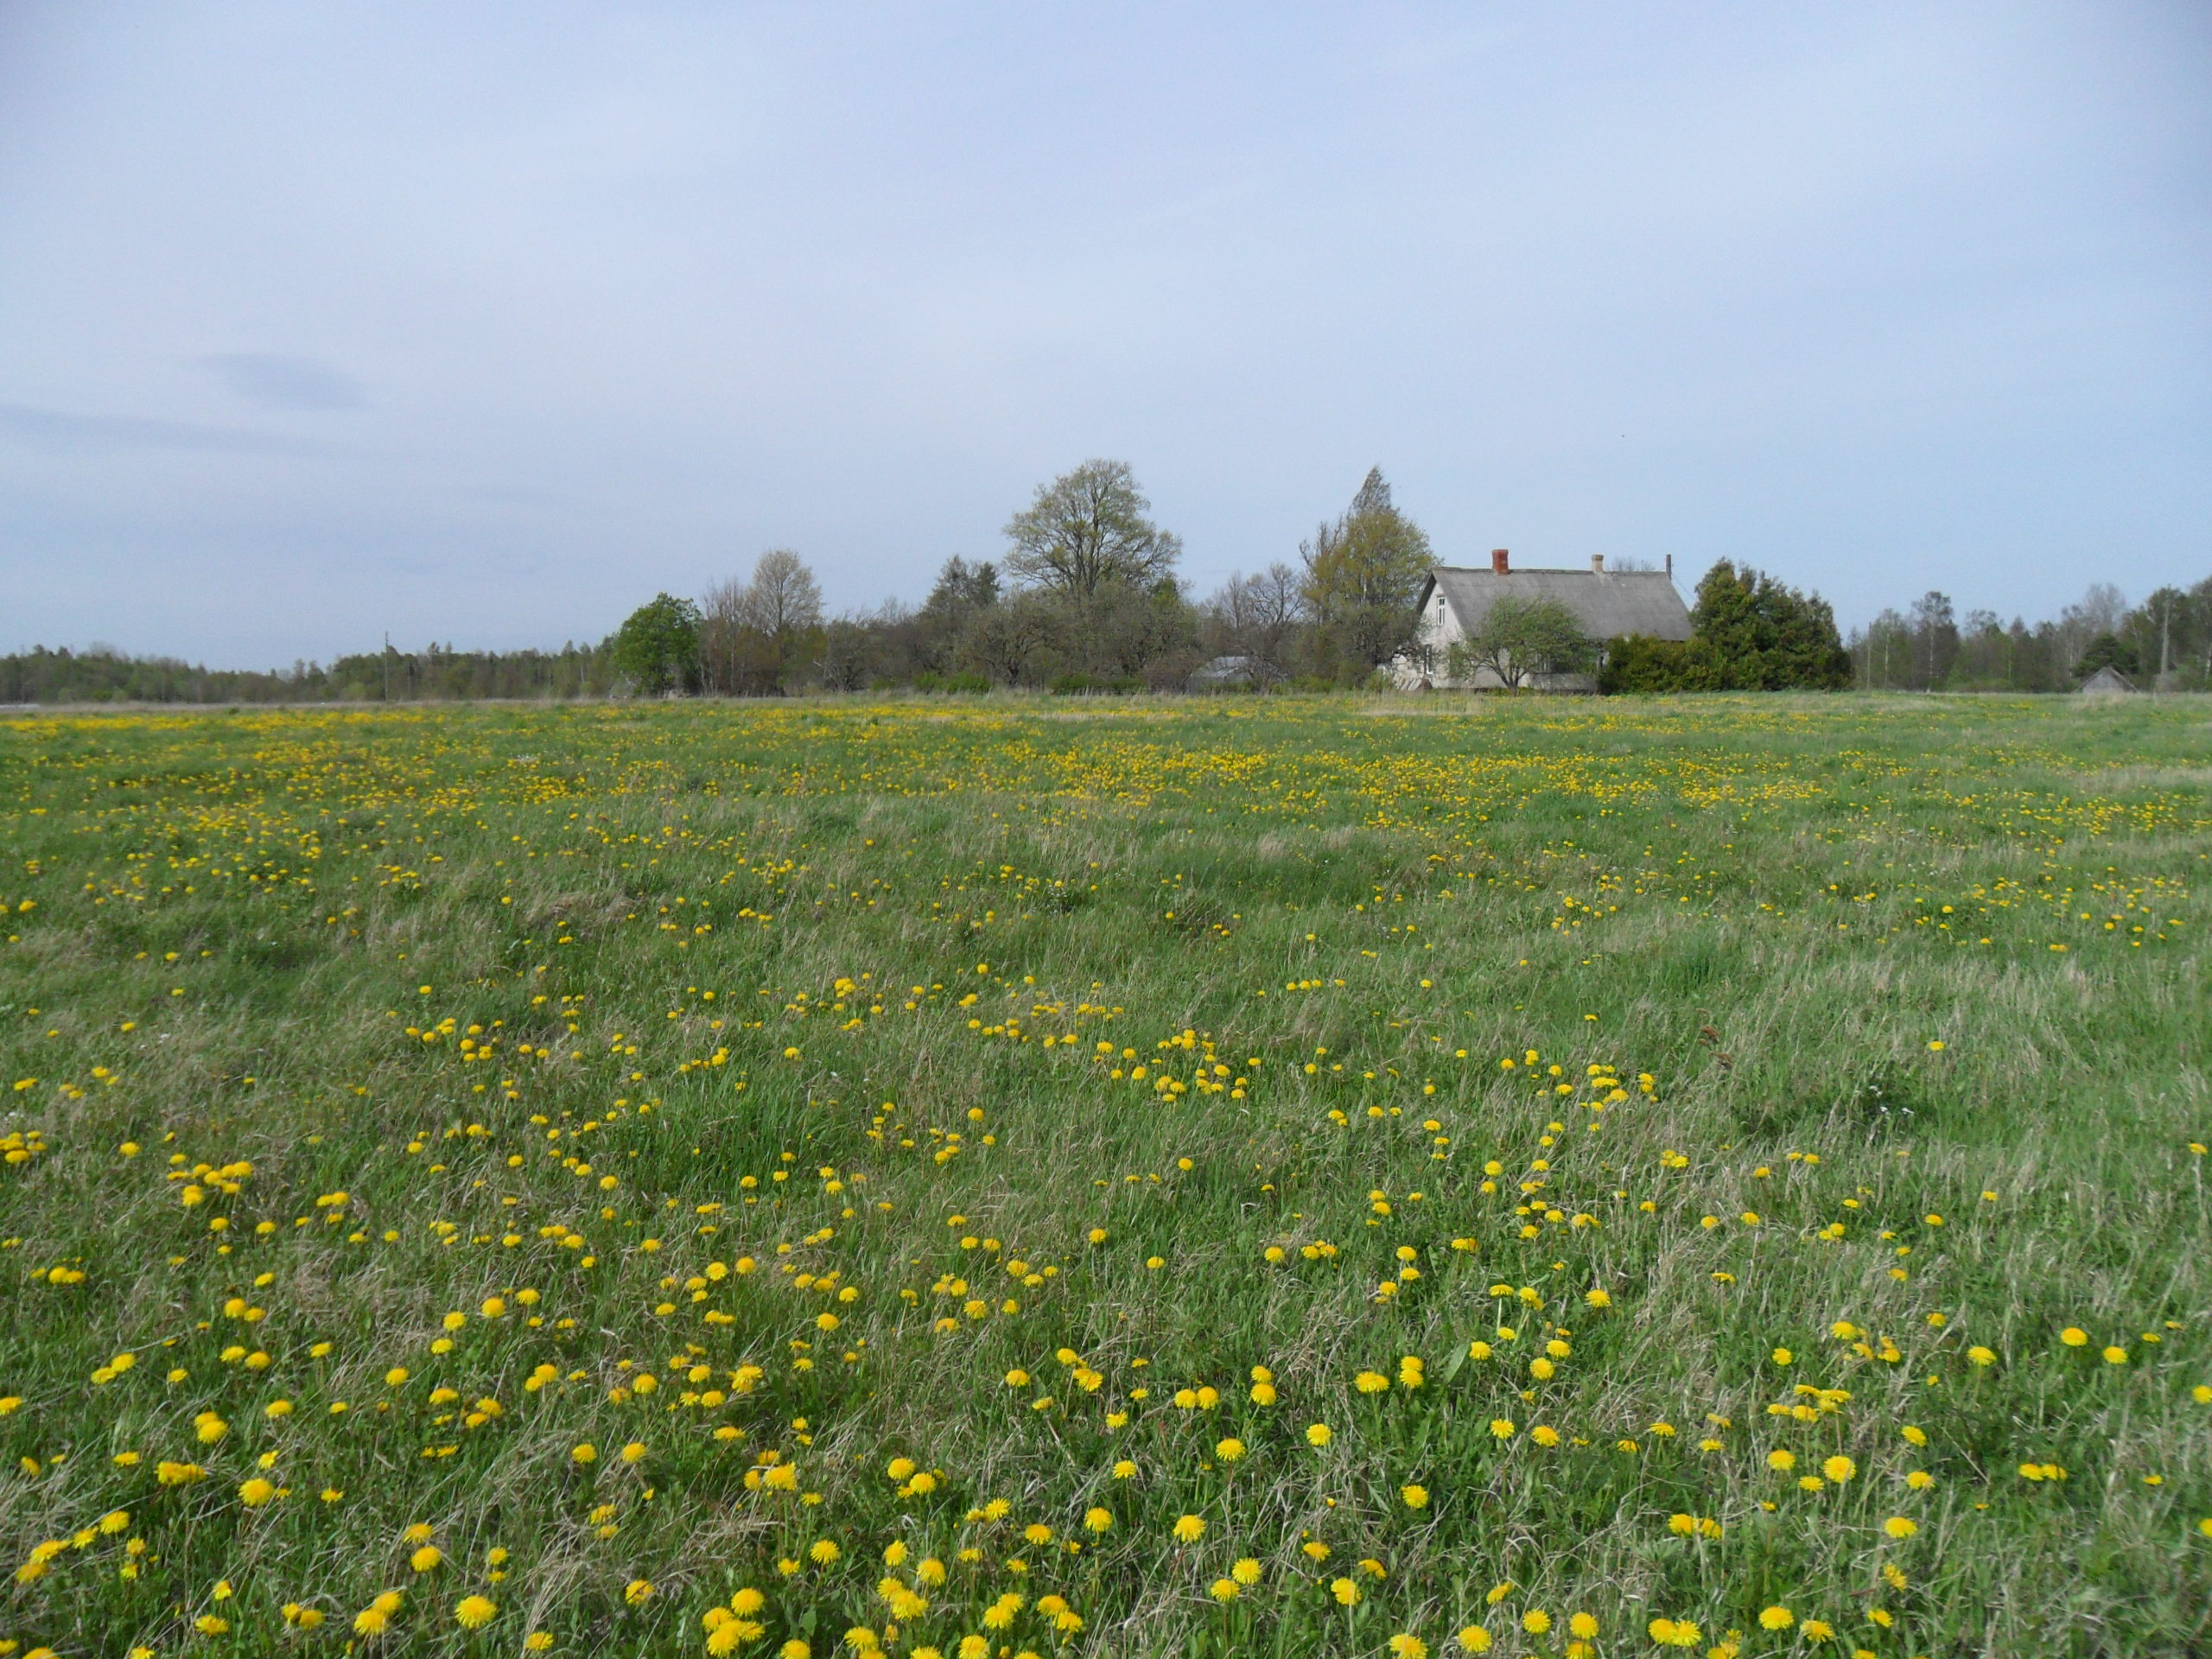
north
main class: Grassland
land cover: Grassland without tree/shrub cover
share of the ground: > 75 %
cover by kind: herbaceous plants 100 %
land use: Agriculture (excluding fallow land and kitchen gardens)
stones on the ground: < 10 %
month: May
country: LV
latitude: 57.2871
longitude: 23.0537
